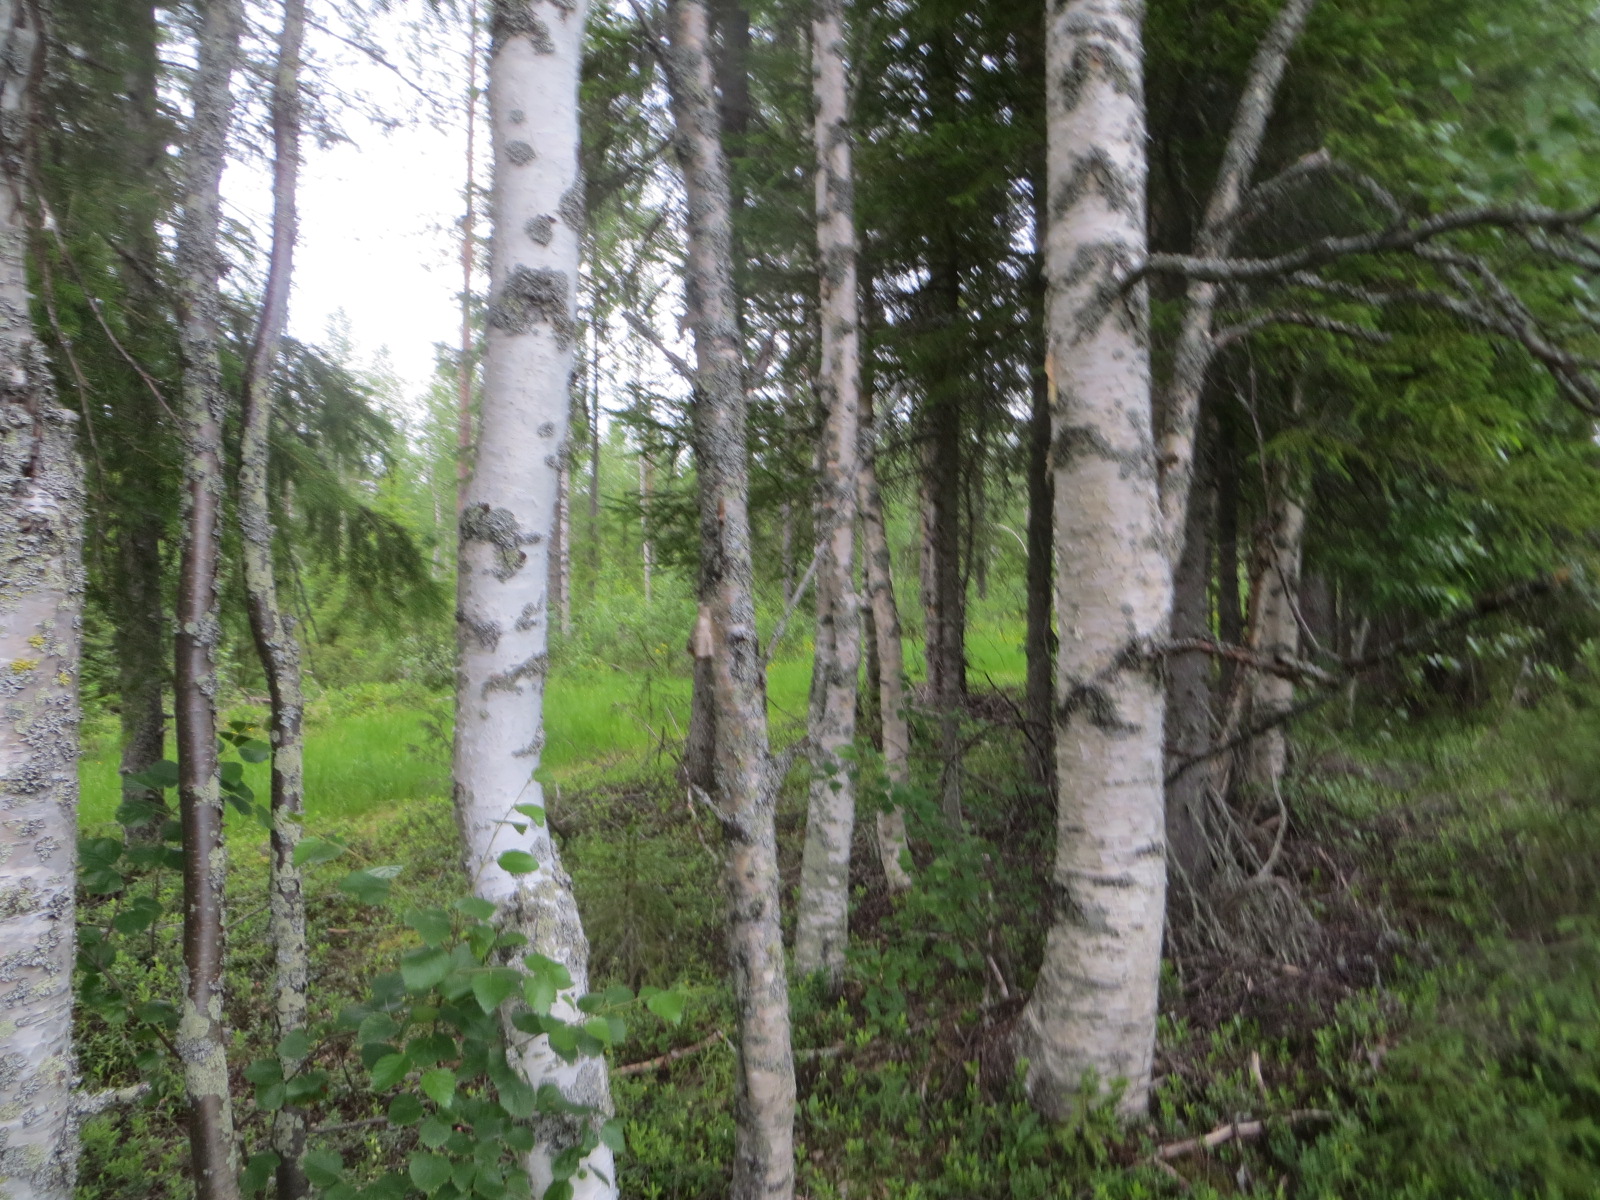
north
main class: Woodland
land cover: Other mixed woodland
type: boreal forest
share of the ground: 50 - 75 %
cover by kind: coniferous forest trees 40 %, broadleaved forest trees 30 %, shrubs 30 %
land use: Forestry
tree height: > 5 m
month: July
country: FI
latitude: 65.9442
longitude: 26.0678
